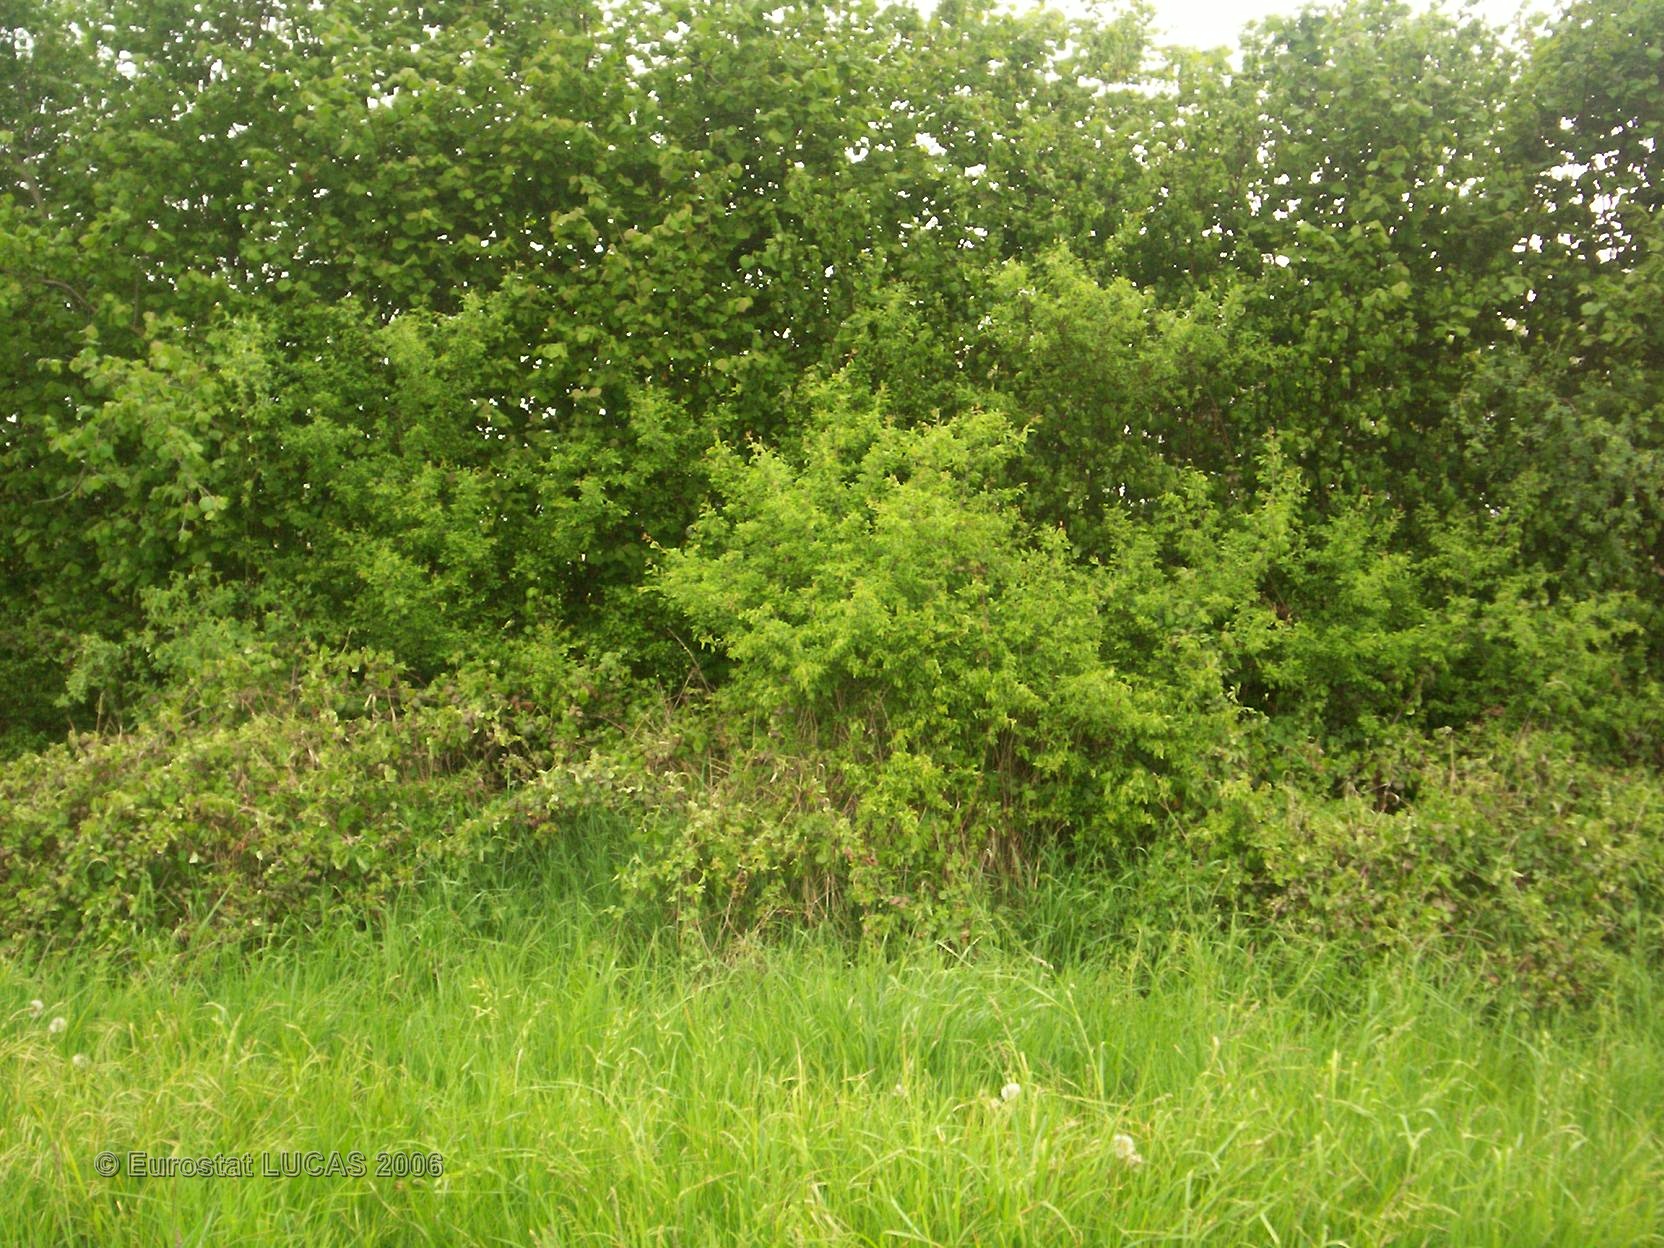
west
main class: Grassland
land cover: Grassland without tree/shrub cover
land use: Agriculture (excluding fallow land and kitchen gardens)
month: May
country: FR
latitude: 47.9489
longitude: 0.4026
